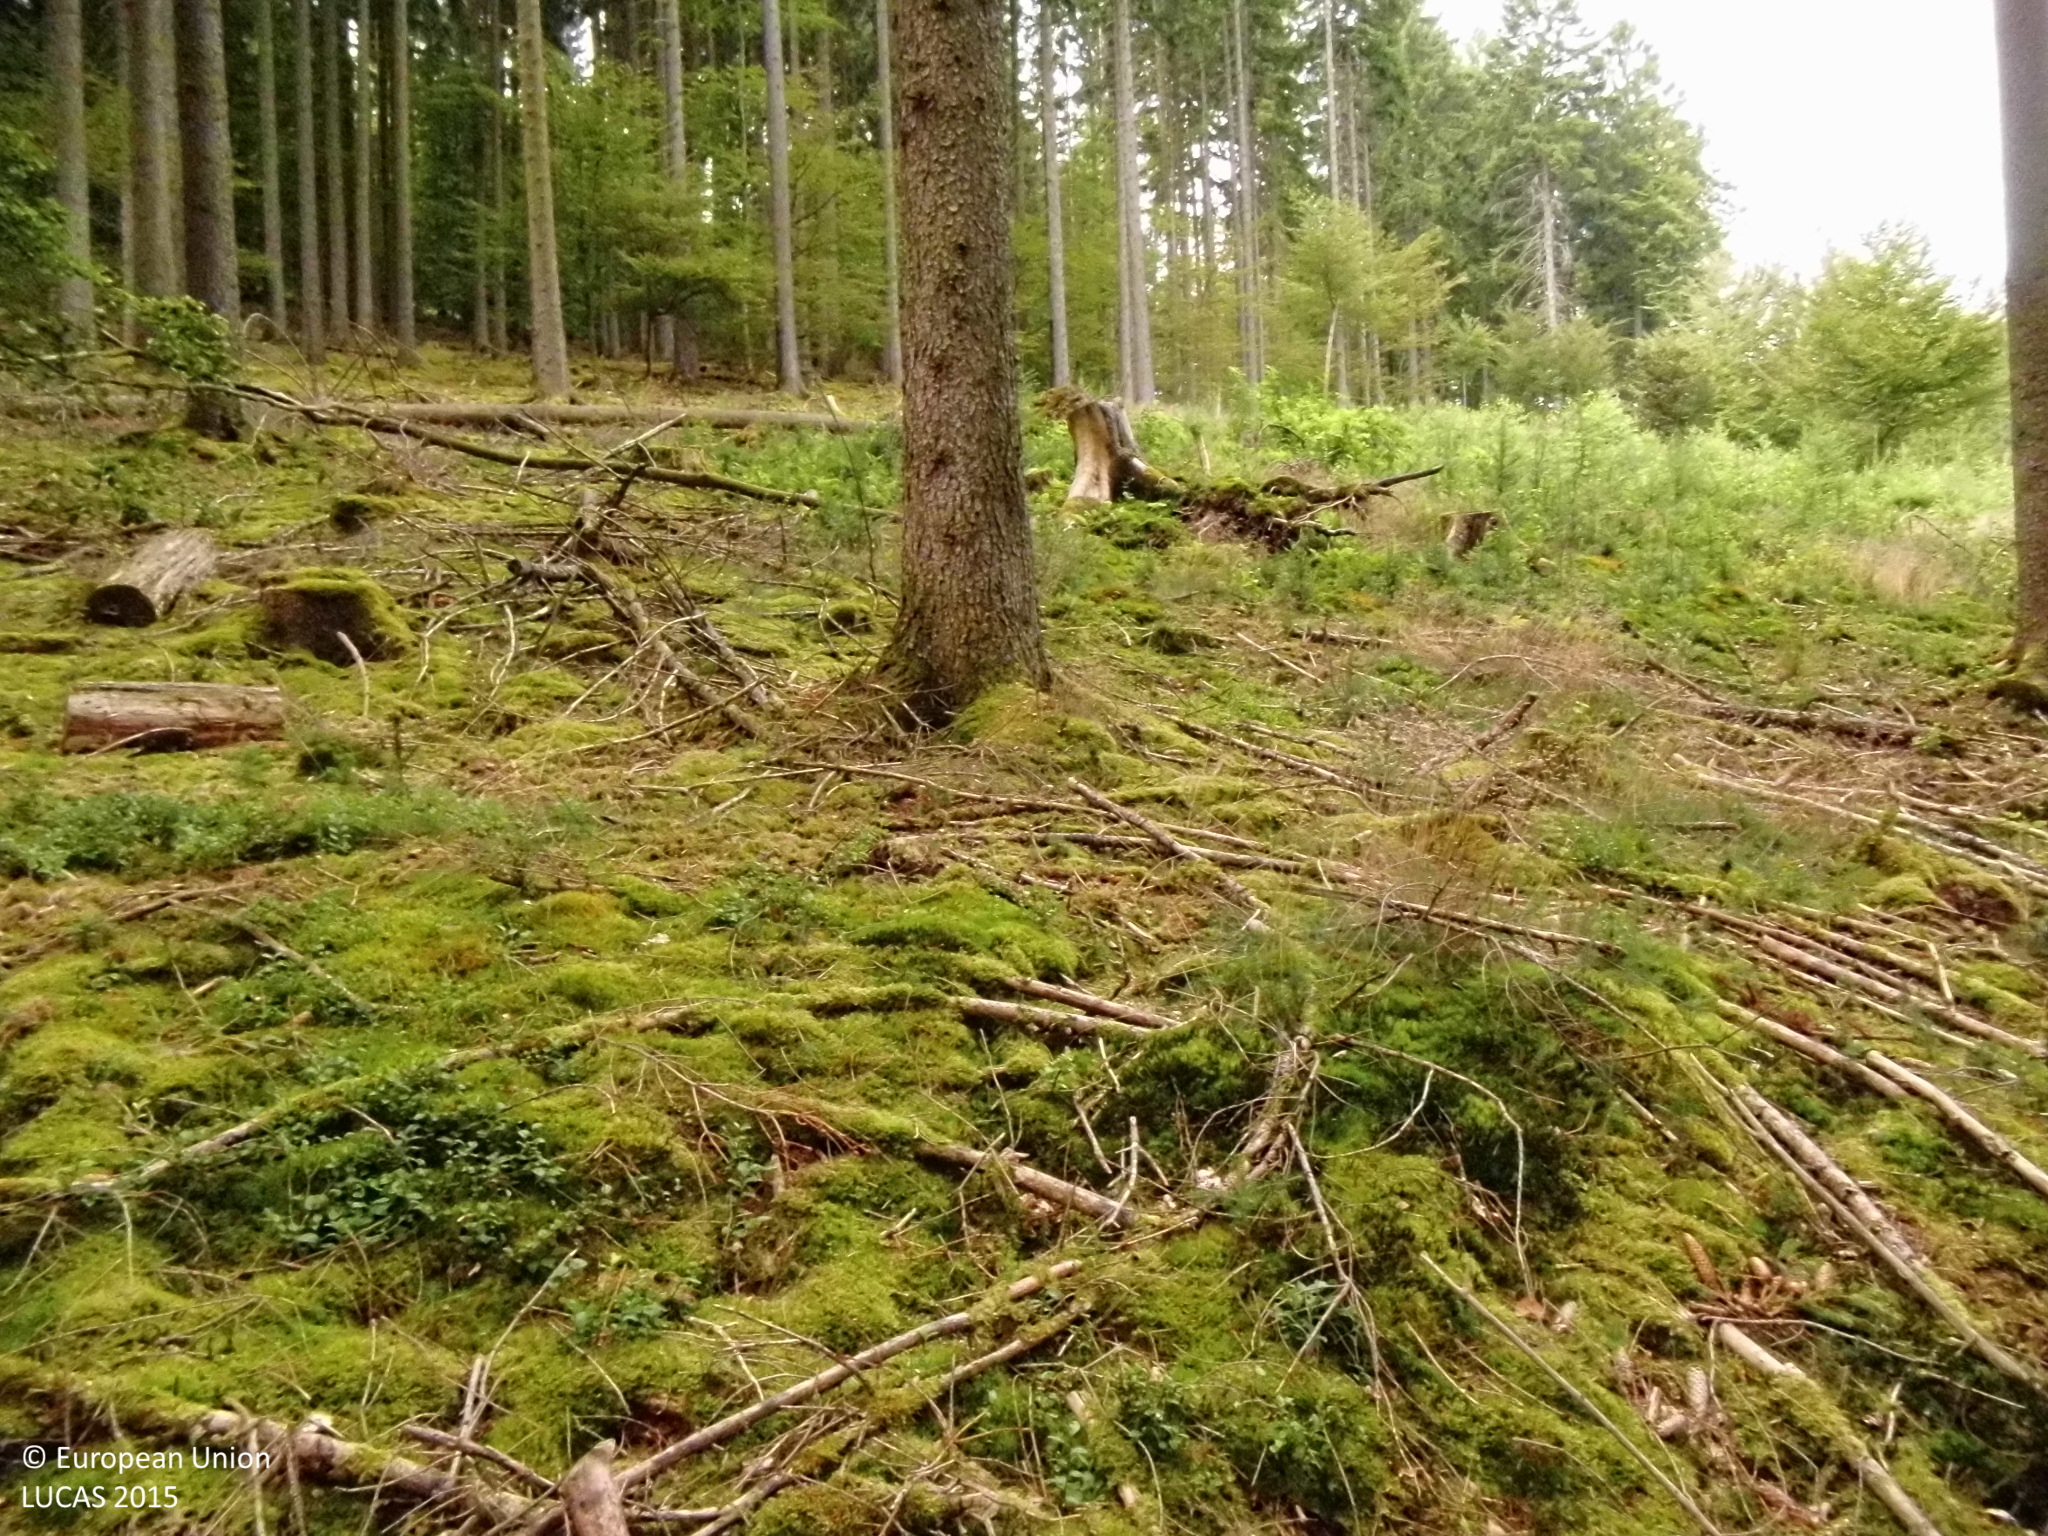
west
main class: Woodland
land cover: Spruce dominated coniferous woodland
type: hemiboreal forest and nemoral coniferous forest and mixed broadleaved-coniferous forest
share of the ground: > 75 %
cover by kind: coniferous forest trees 65 %, broadleaved forest trees 15 %, lichens and mosses 10 %, shrubs 5 %, unconsolidated bare surface 5 %
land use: Forestry
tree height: > 5 m
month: August
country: DE
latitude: 50.9847
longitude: 8.5901
